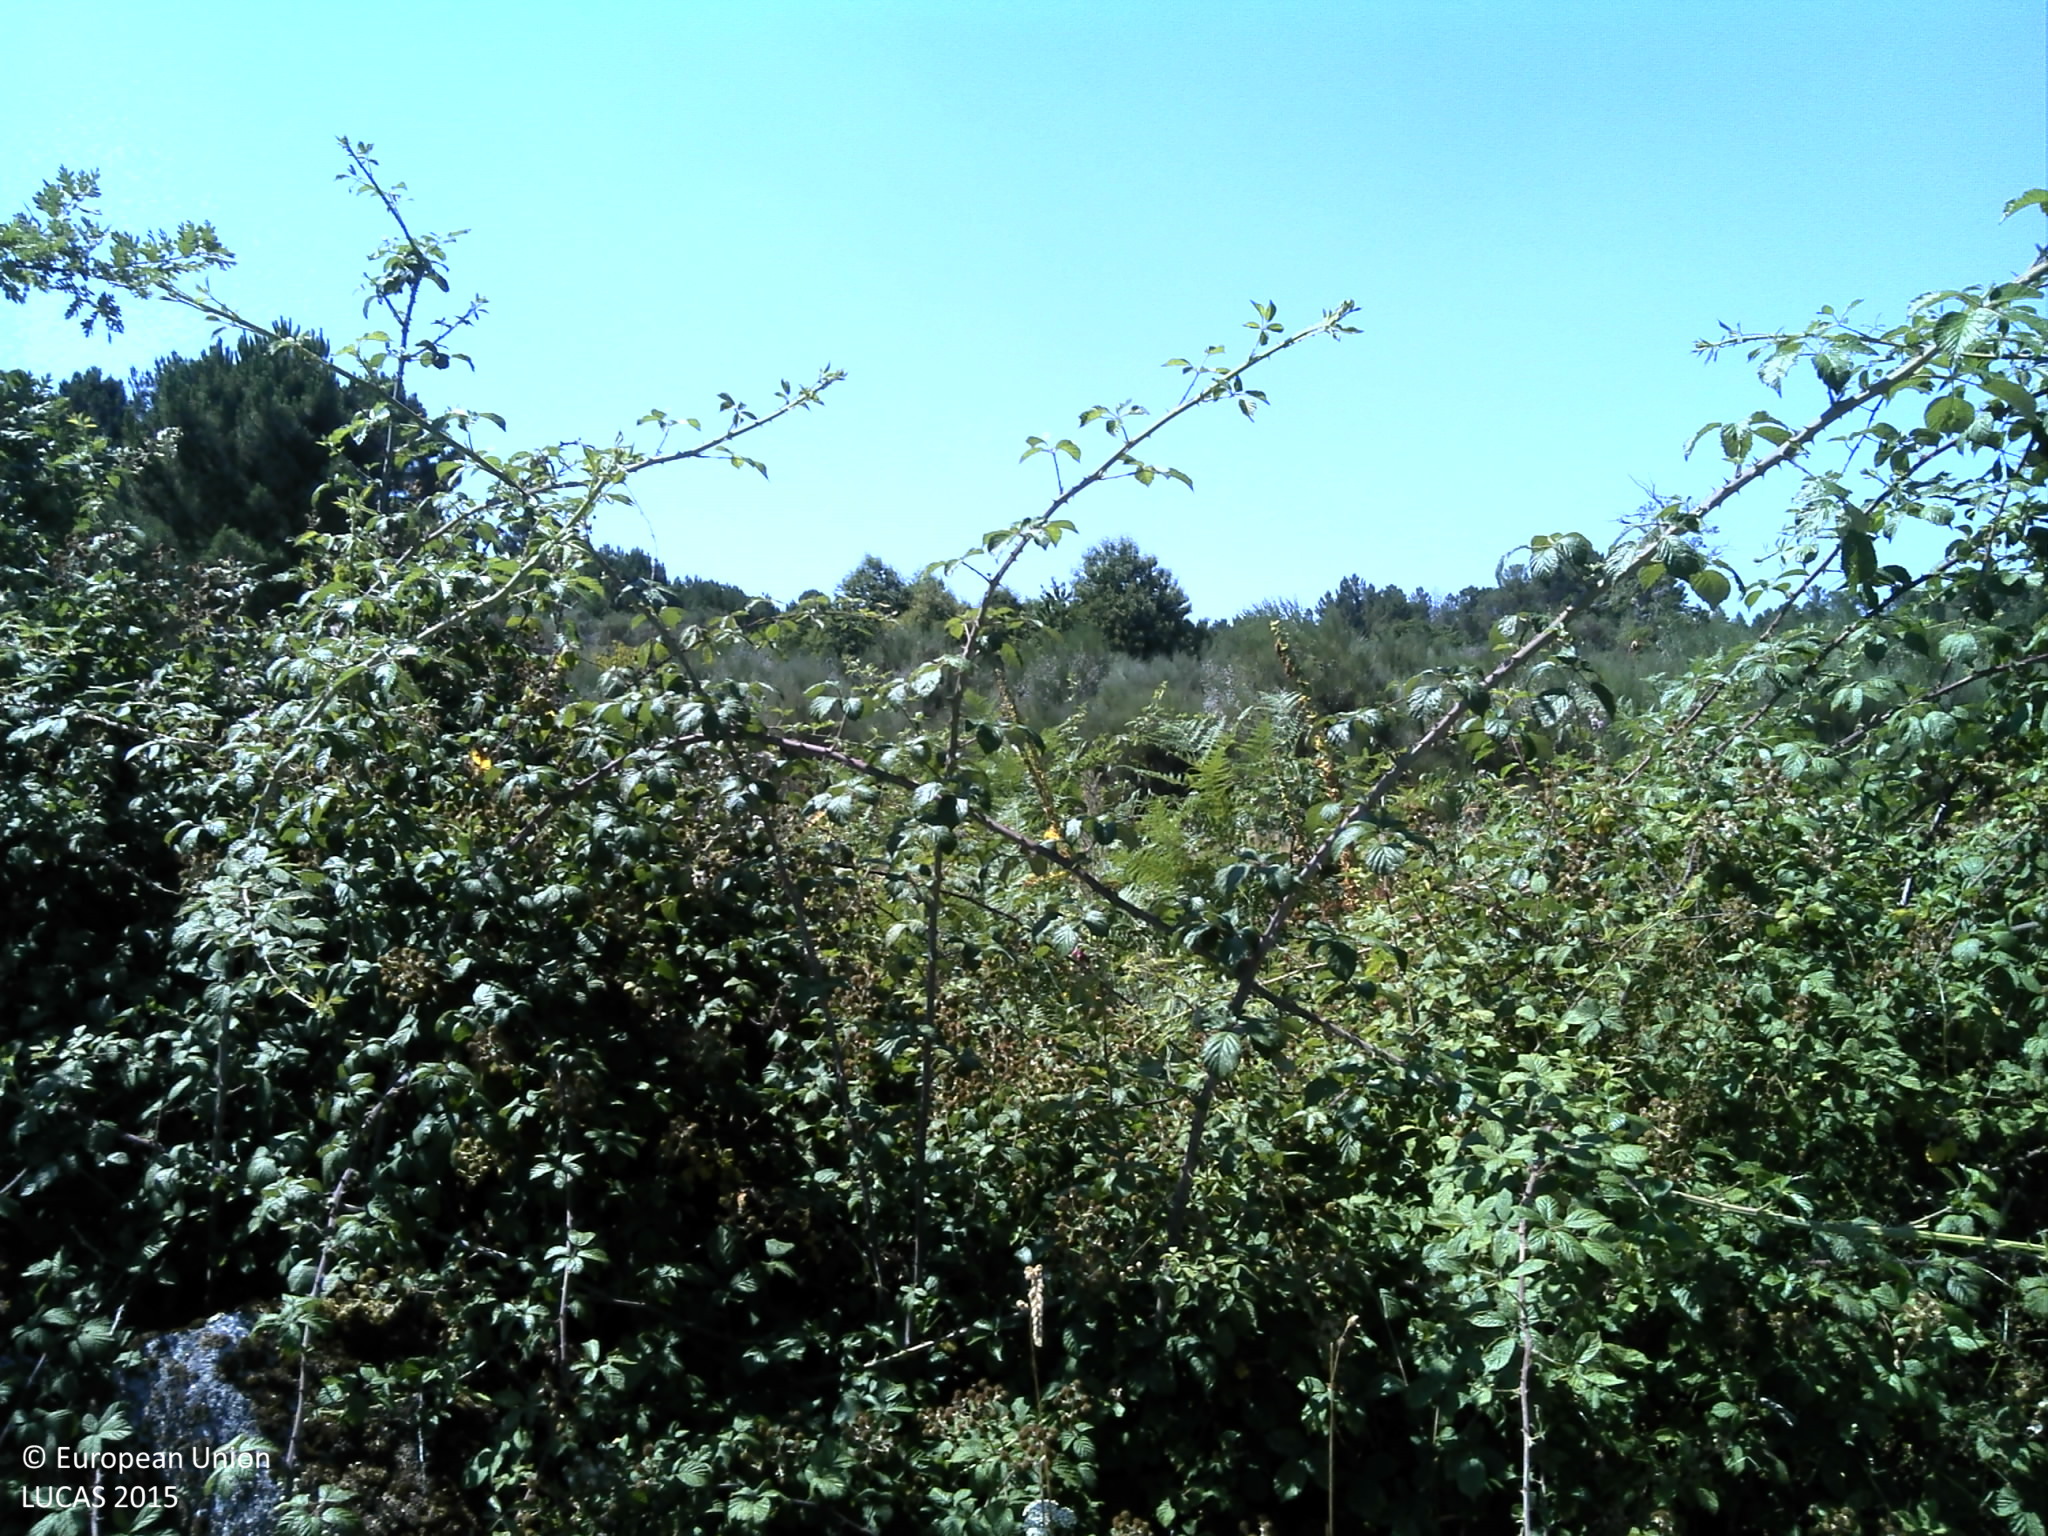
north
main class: Grassland
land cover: Grassland without tree/shrub cover
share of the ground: > 75 %
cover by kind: herbaceous plants 75 %, unconsolidated bare surface 20 %, shrubs 5 %
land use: Abandoned areas
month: July
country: PT
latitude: 40.8372
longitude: -7.5146
